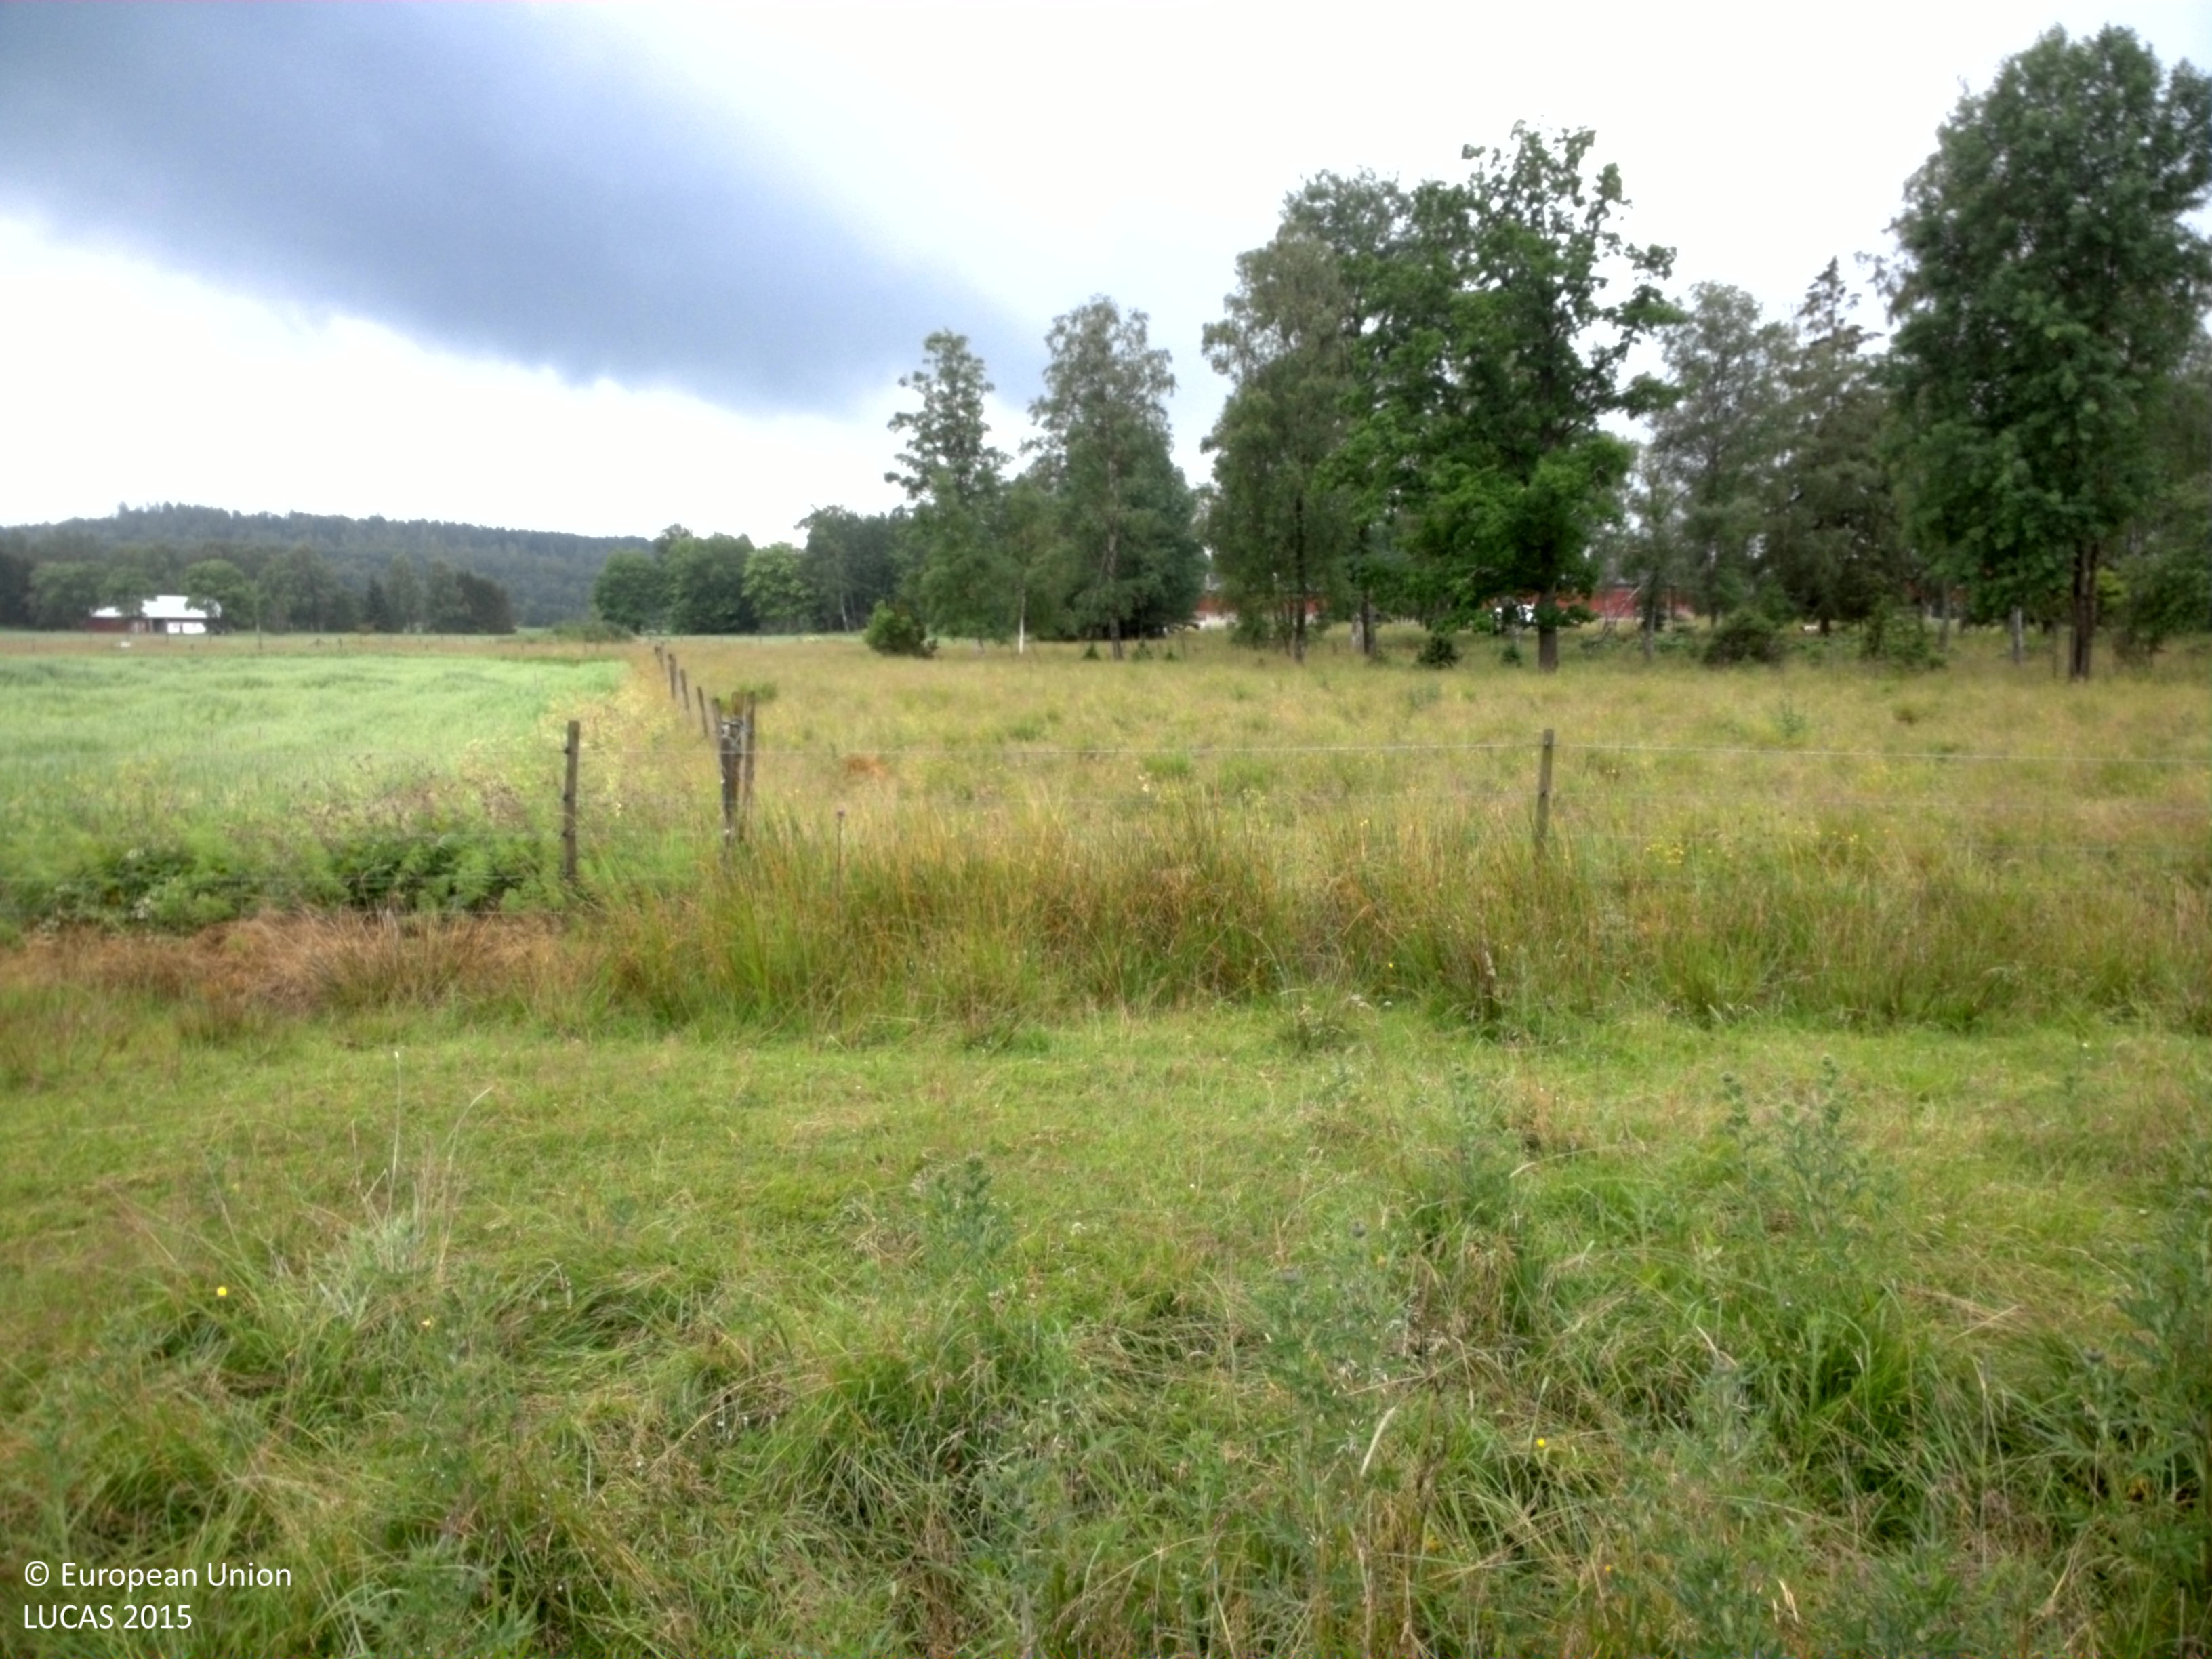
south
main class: Grassland
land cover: Grassland without tree/shrub cover
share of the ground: > 75 %
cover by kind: herbaceous plants 100 %
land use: Agriculture (excluding fallow land and kitchen gardens)
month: July
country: SE
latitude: 58.1963
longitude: 13.9921
